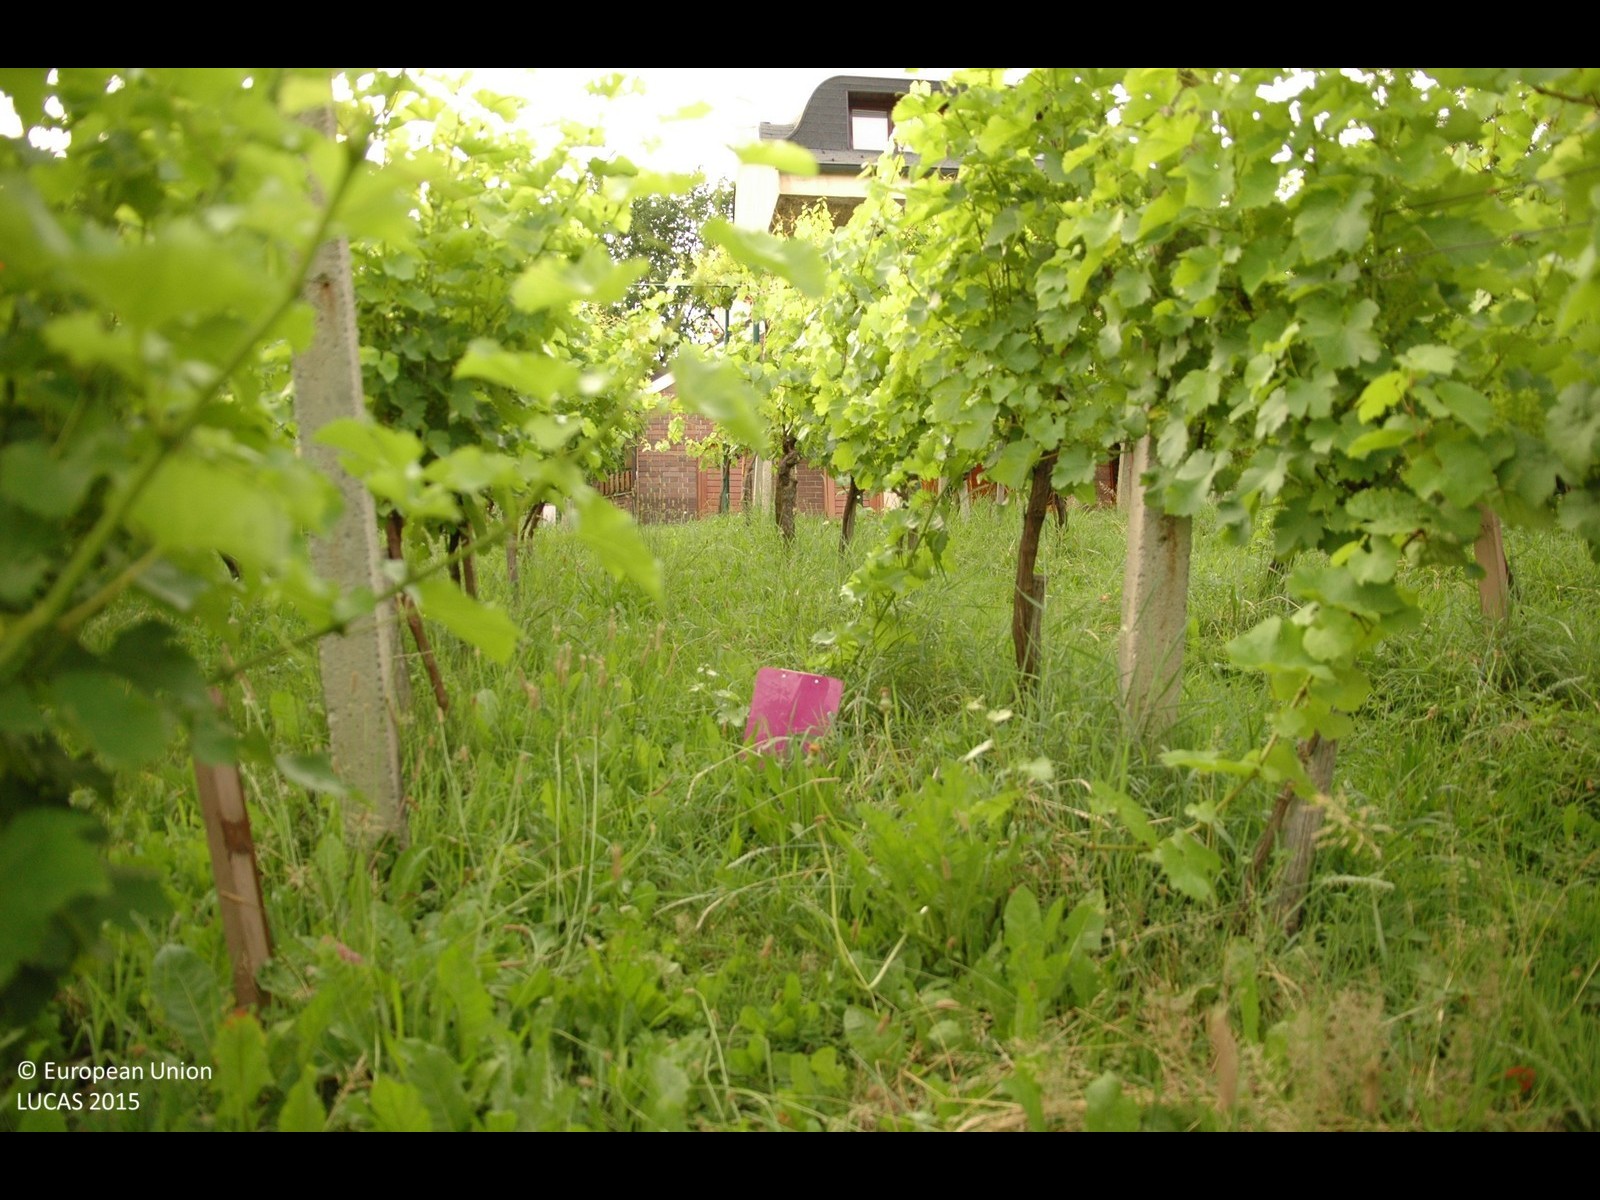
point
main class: Cropland
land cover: Vineyards
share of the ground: 50 - 75 %
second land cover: Grassland without tree/shrub cover
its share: 25 - 50 %
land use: Agriculture (excluding fallow land and kitchen gardens)
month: June
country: HR
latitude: 46.2127
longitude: 16.4164
